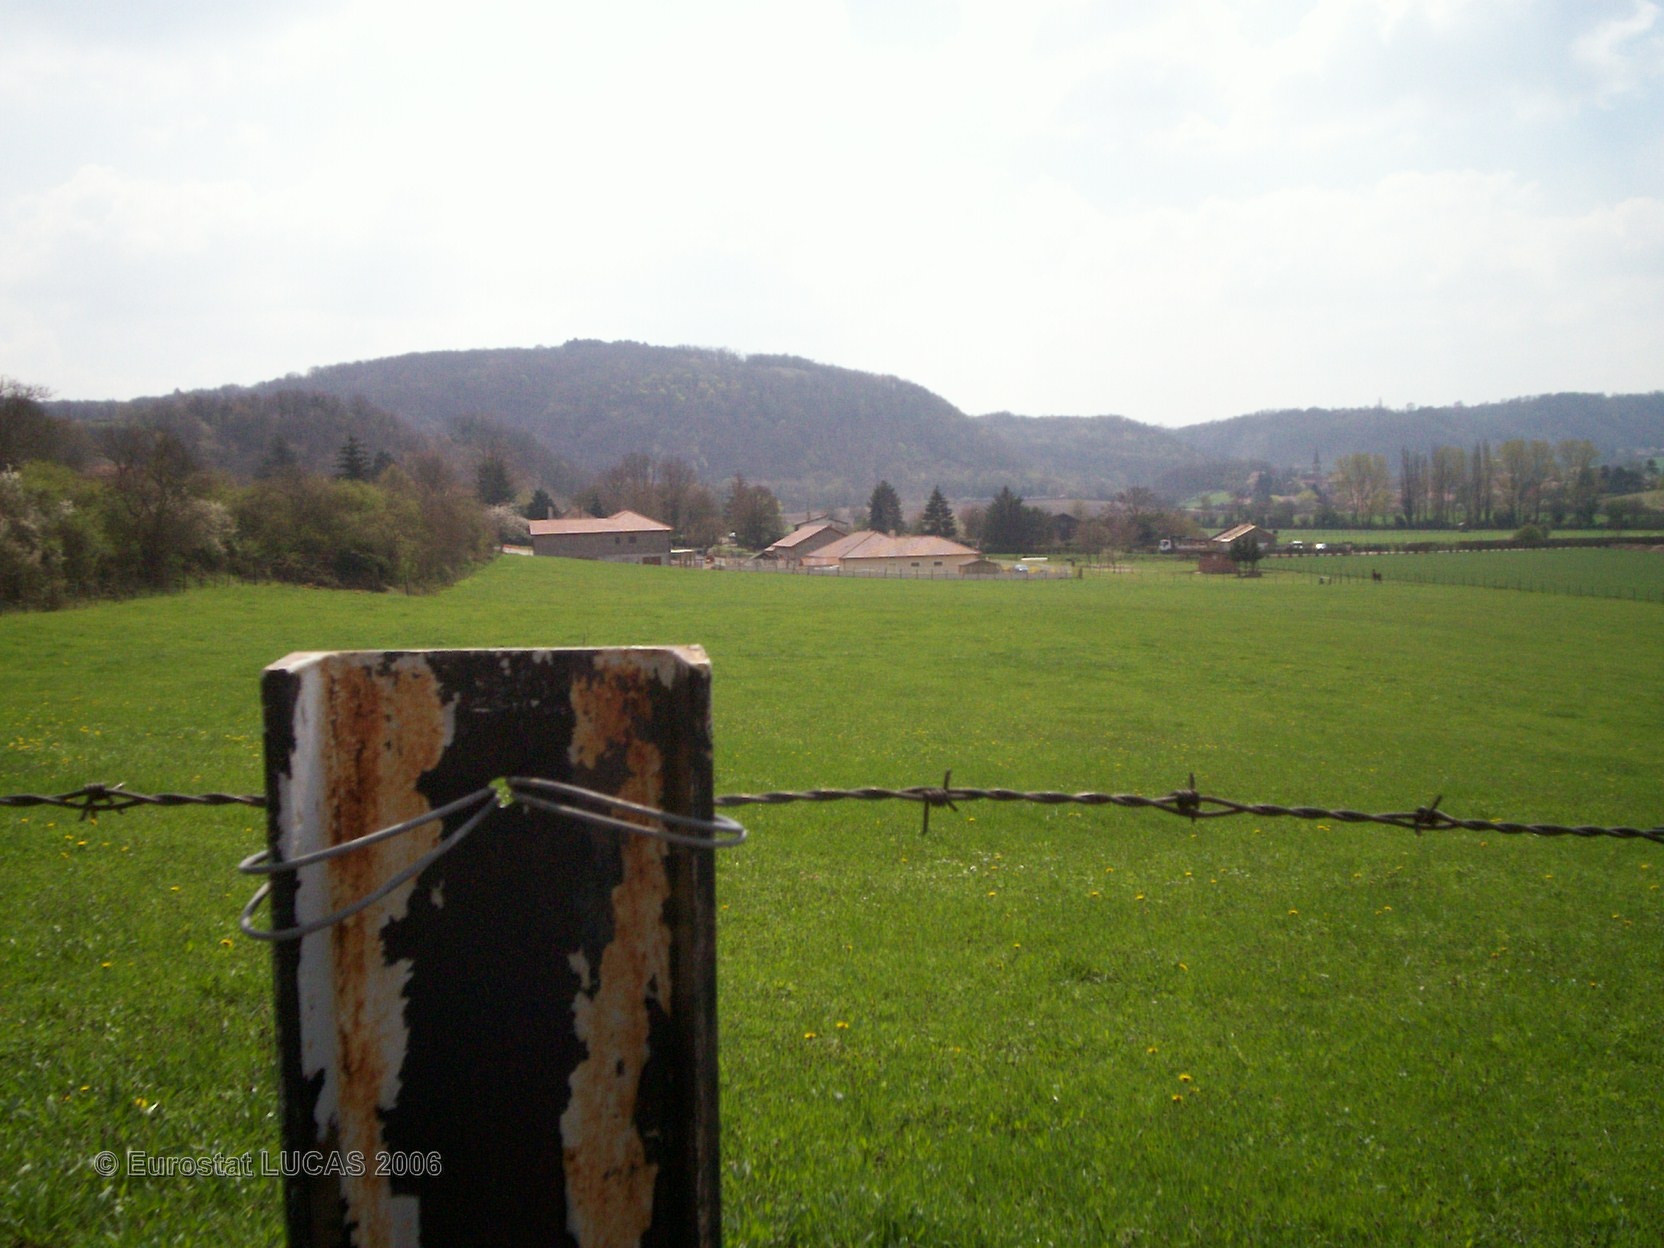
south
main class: Grassland
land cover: Grassland without tree/shrub cover
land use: Agriculture (excluding fallow land and kitchen gardens)
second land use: Amenities, museums, leisure
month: April
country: FR
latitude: 45.7027
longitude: 5.2133
